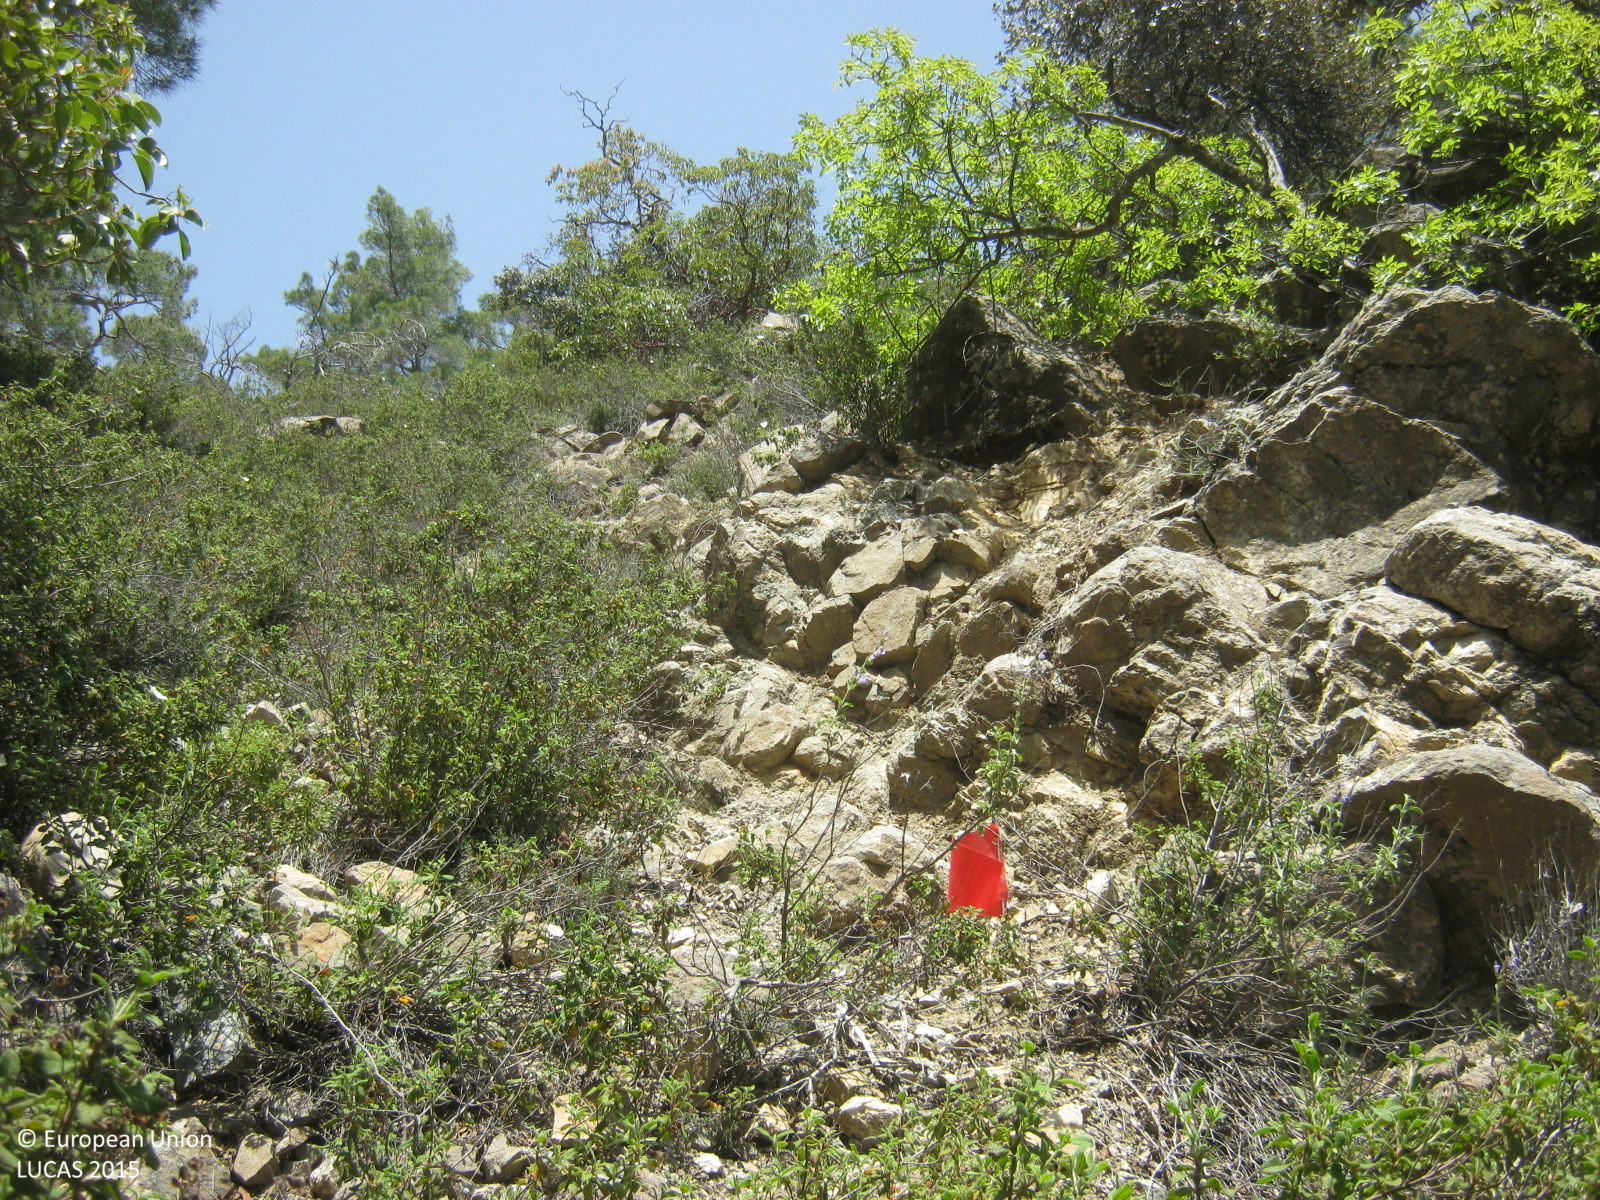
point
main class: Woodland
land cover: Pine dominated mixed woodland
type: coniferous forest of the mediterranean region
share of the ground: 50 - 75 %
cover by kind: coniferous forest trees 50 %, broadleaved forest trees 25 %, shrubs 10 %, consolidated bare surface 10 %, unconsolidated bare surface 5 %
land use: Forestry
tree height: > 5 m
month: May
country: CY
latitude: 34.9759
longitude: 32.8749
